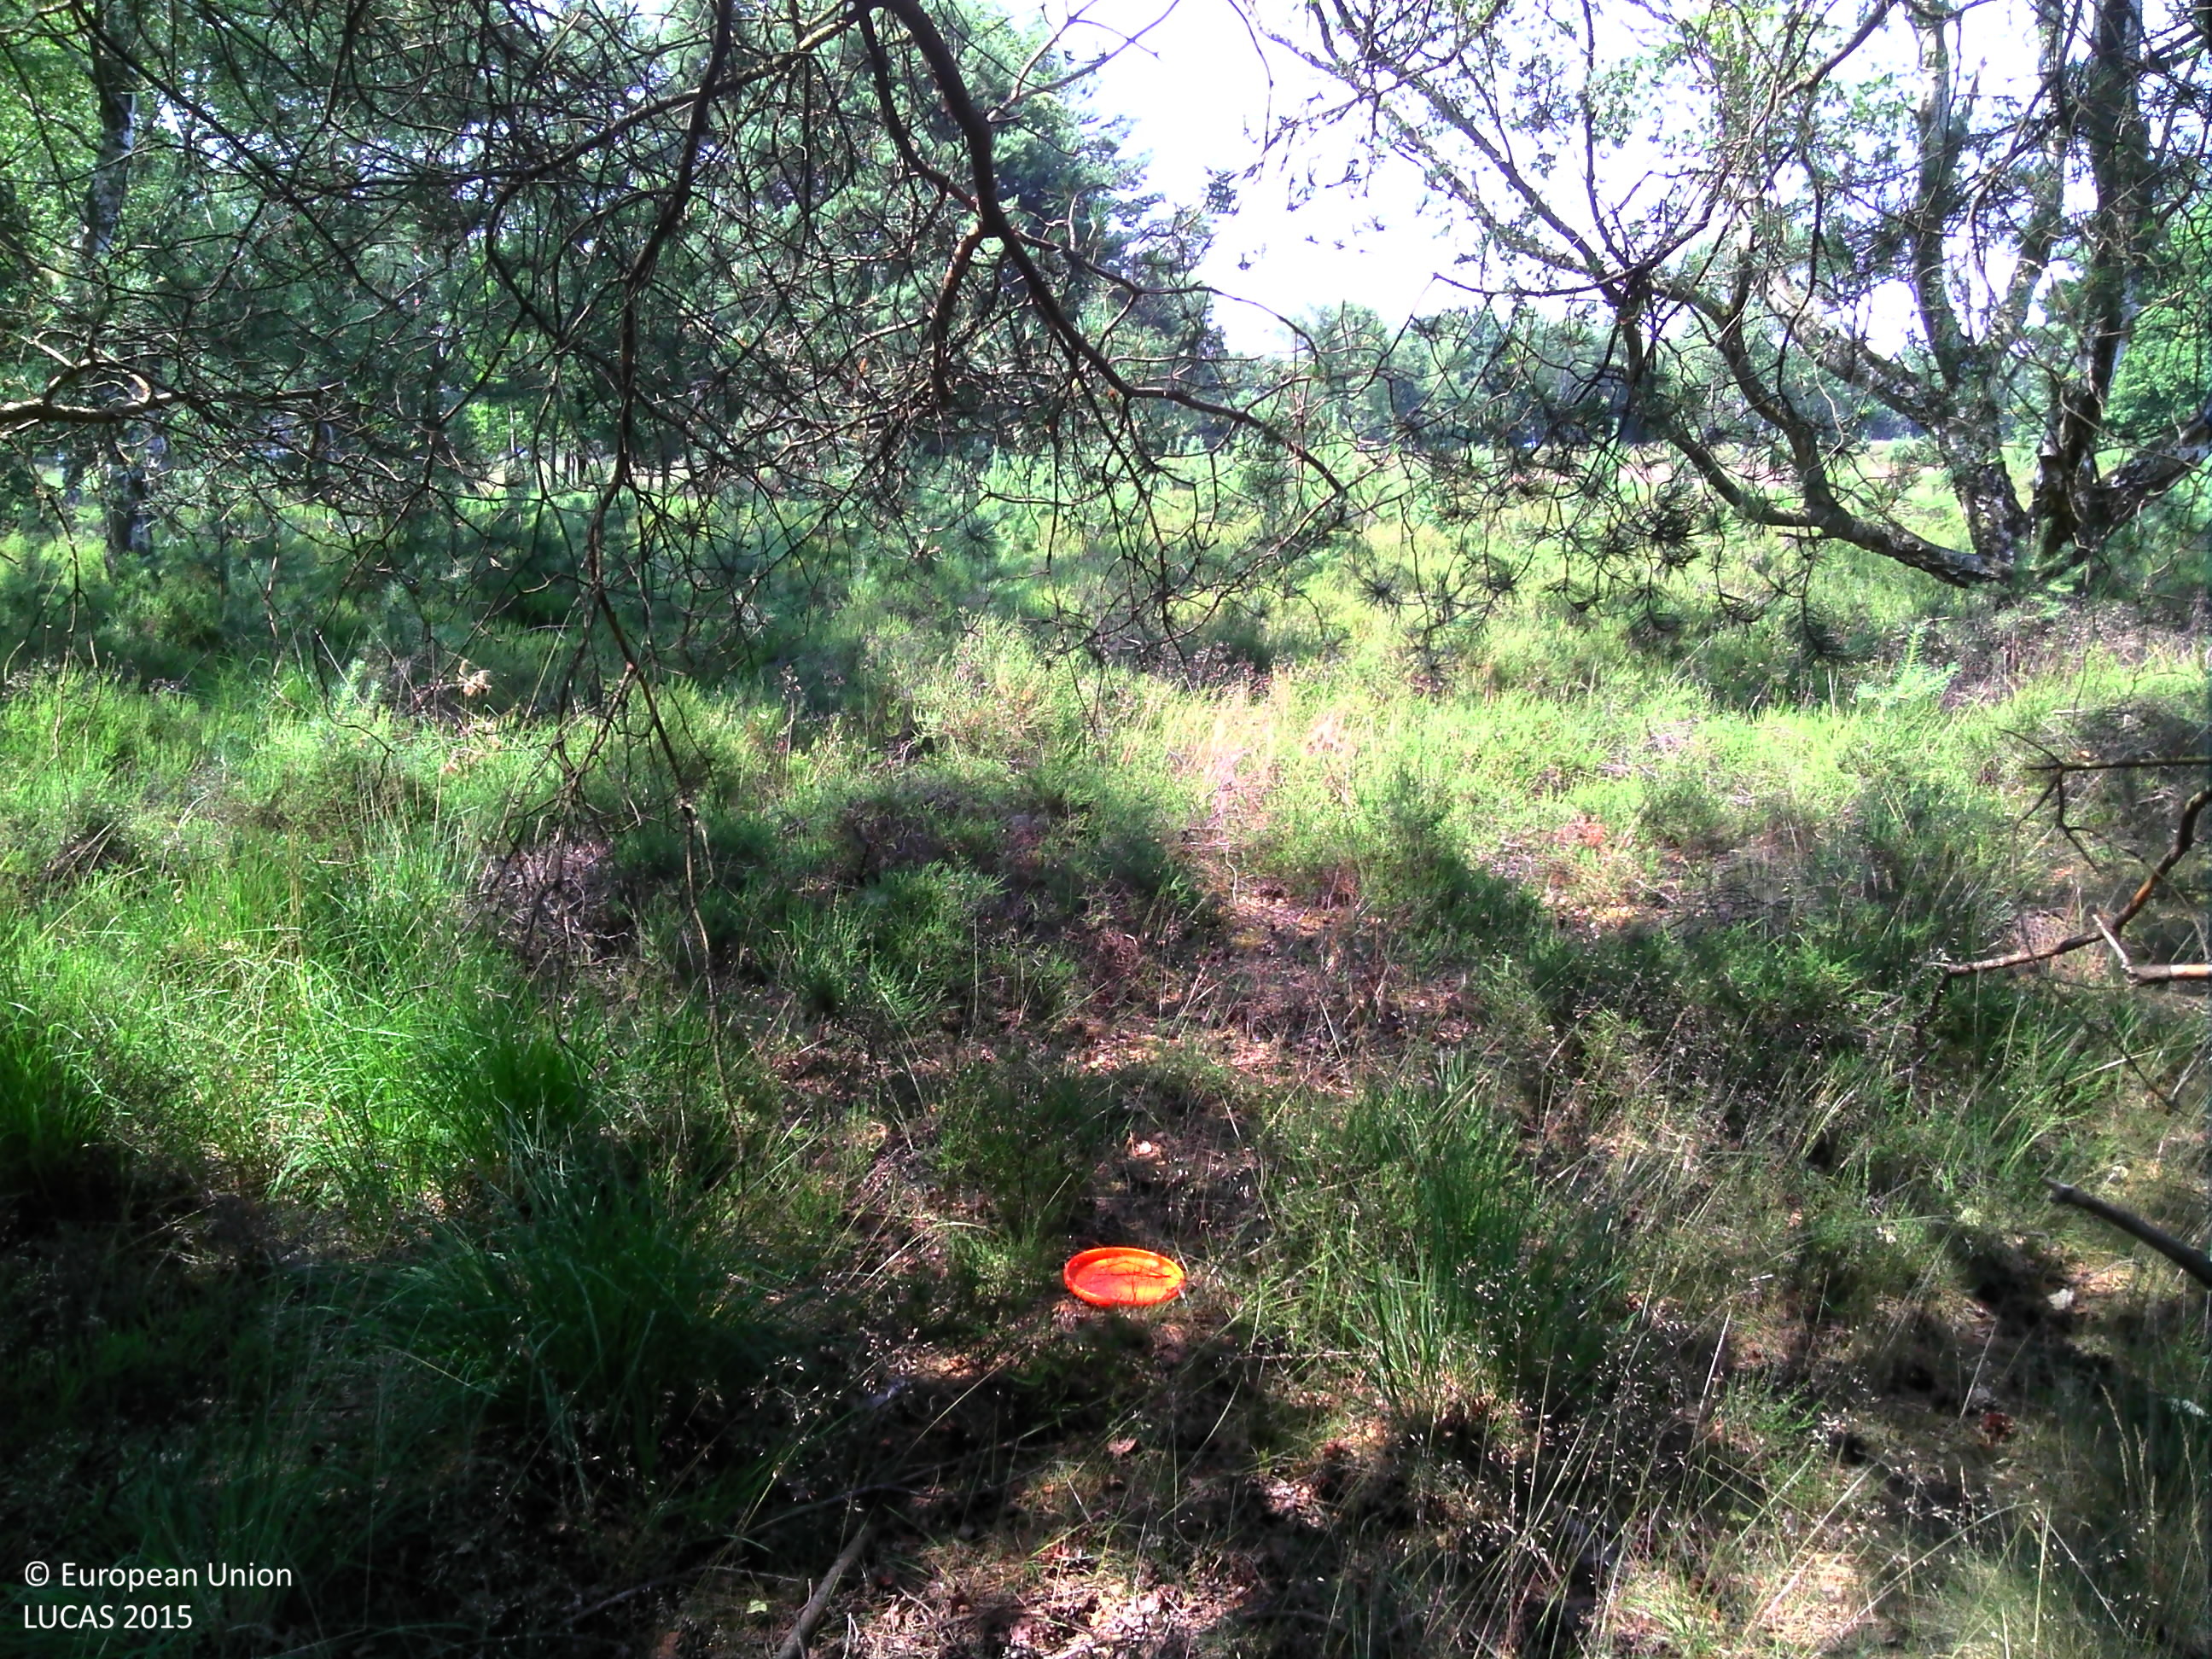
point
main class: Woodland
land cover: Pine dominated mixed woodland
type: hemiboreal forest and nemoral coniferous forest and mixed broadleaved-coniferous forest
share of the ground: > 75 %
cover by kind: coniferous forest trees 50 %, broadleaved forest trees 25 %, herbaceous plants 25 %
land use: Semi-natural and natural areas not in use
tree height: > 5 m
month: July
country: BE
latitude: 51.0109
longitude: 5.4228
